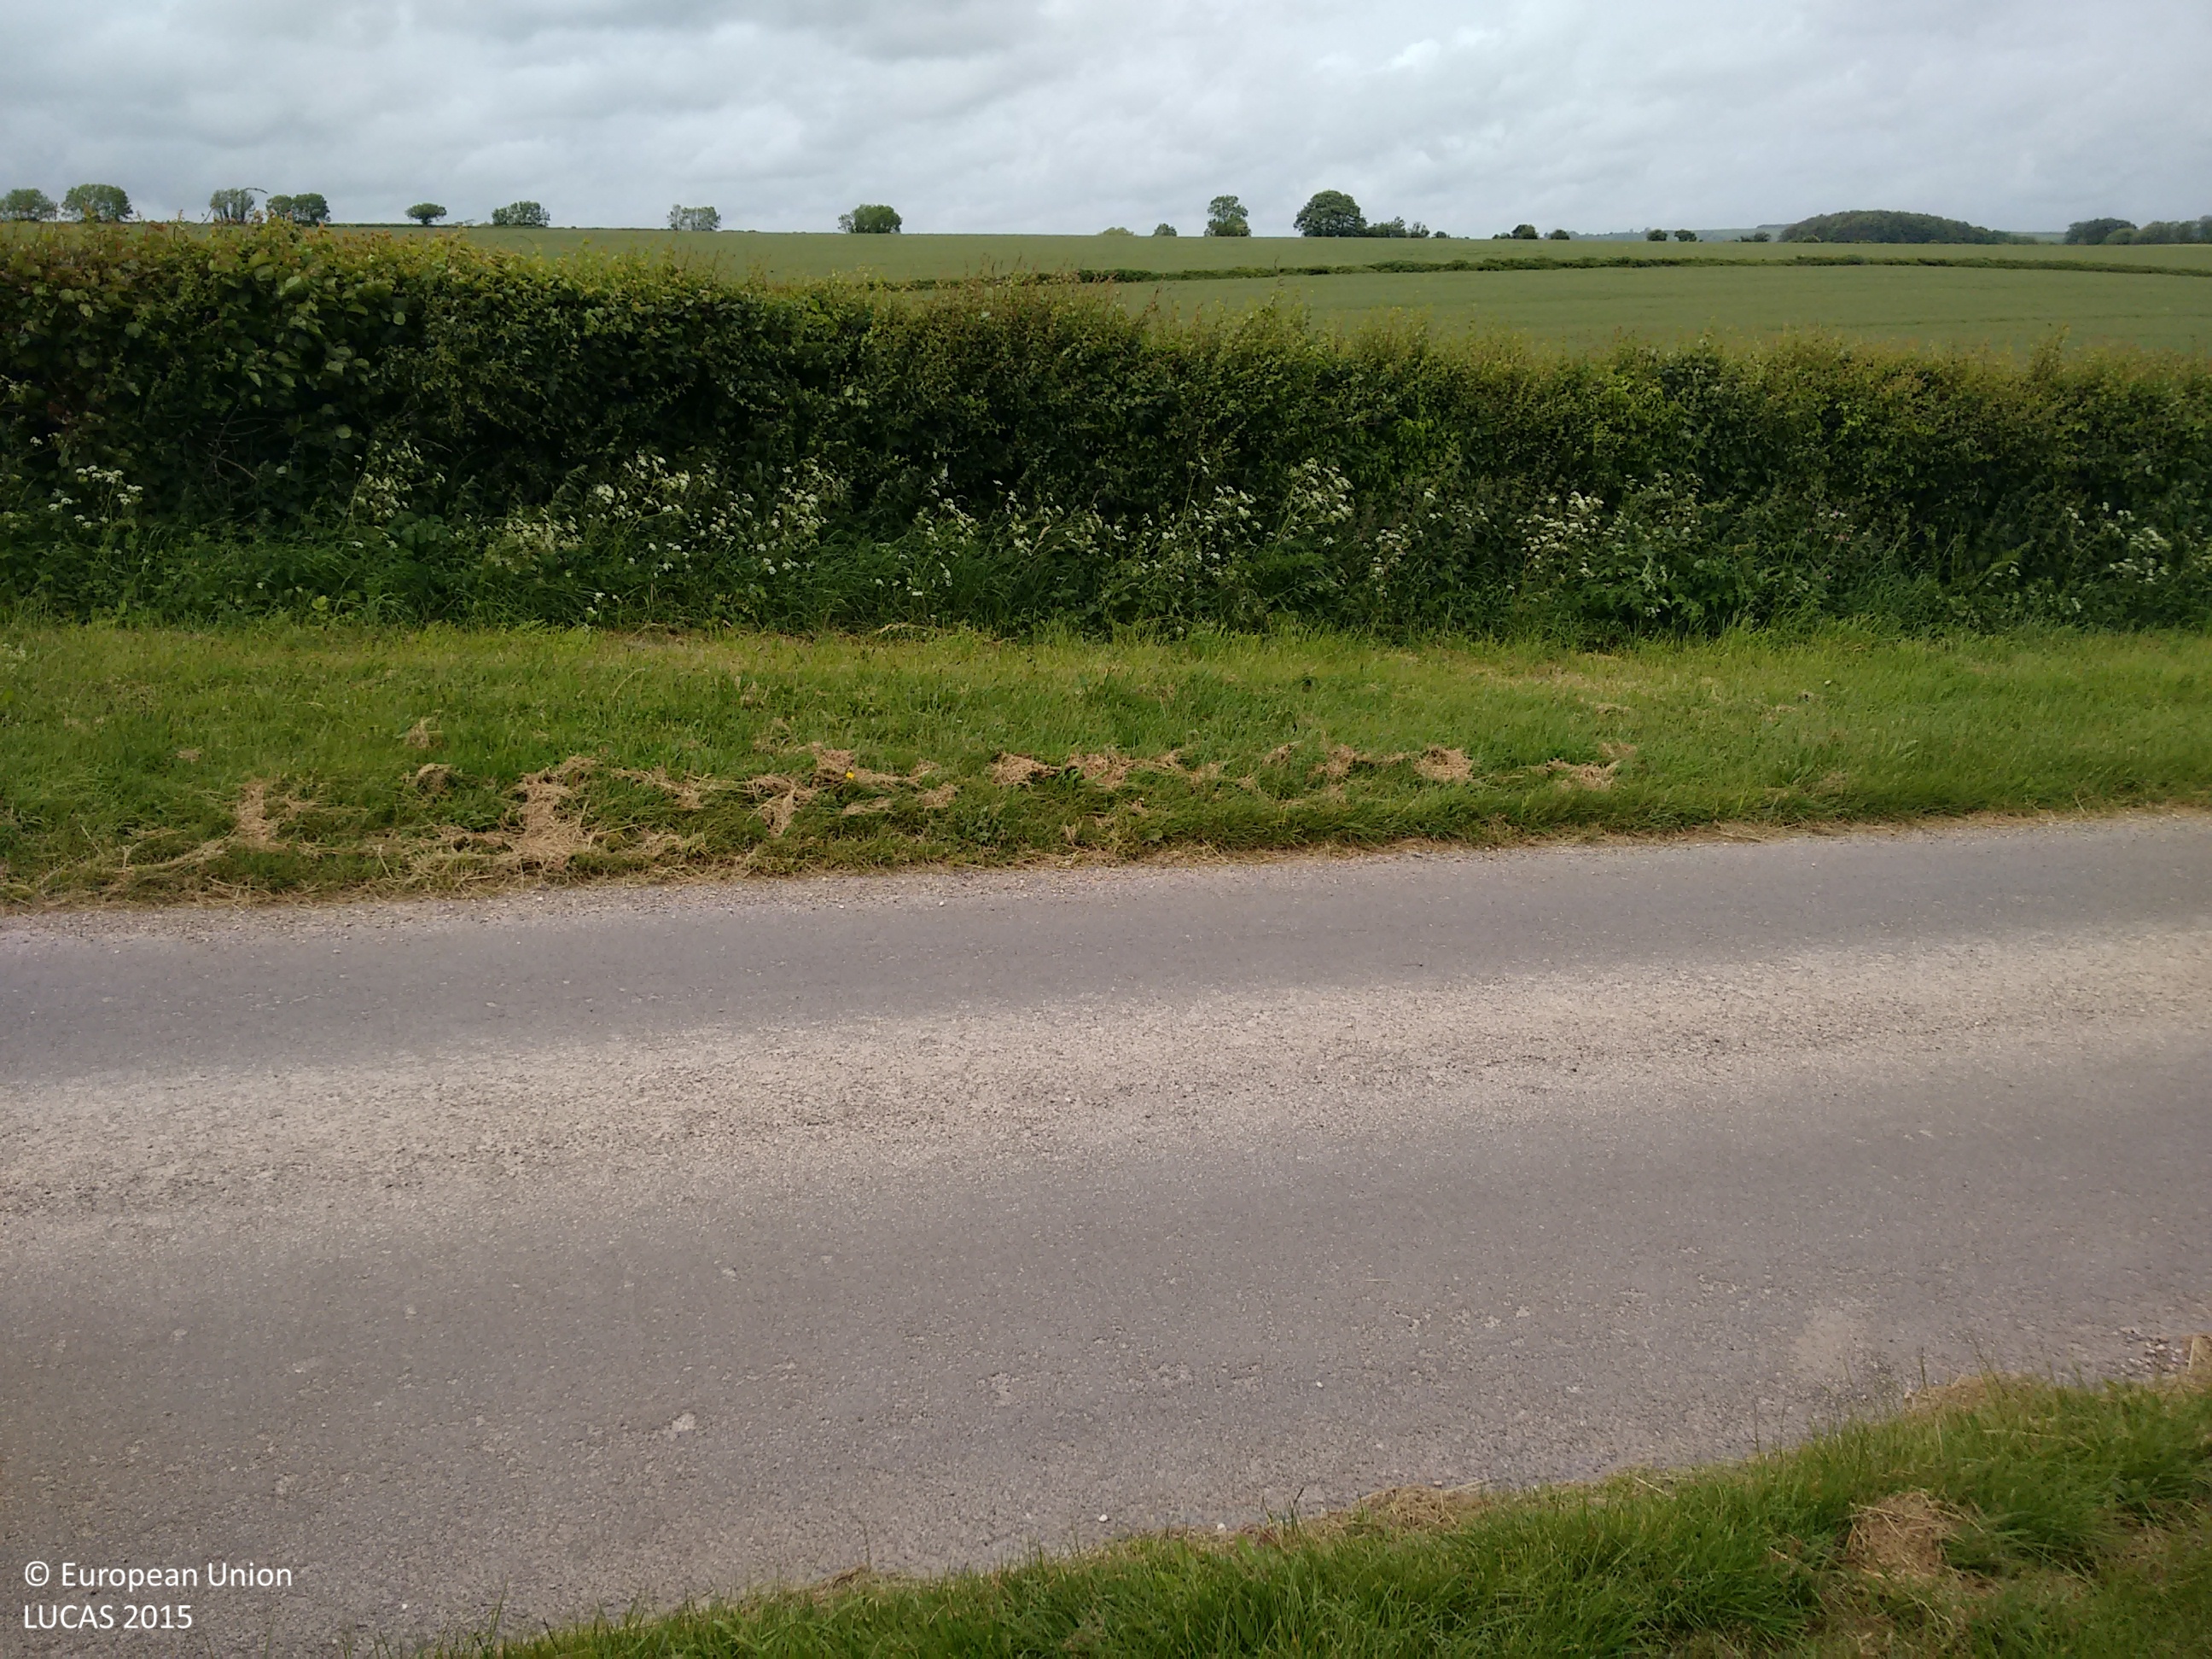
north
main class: Cropland
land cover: Barley
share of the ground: > 75 %
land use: Agriculture (excluding fallow land and kitchen gardens)
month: June
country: GB
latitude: 50.7792
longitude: -2.3887
